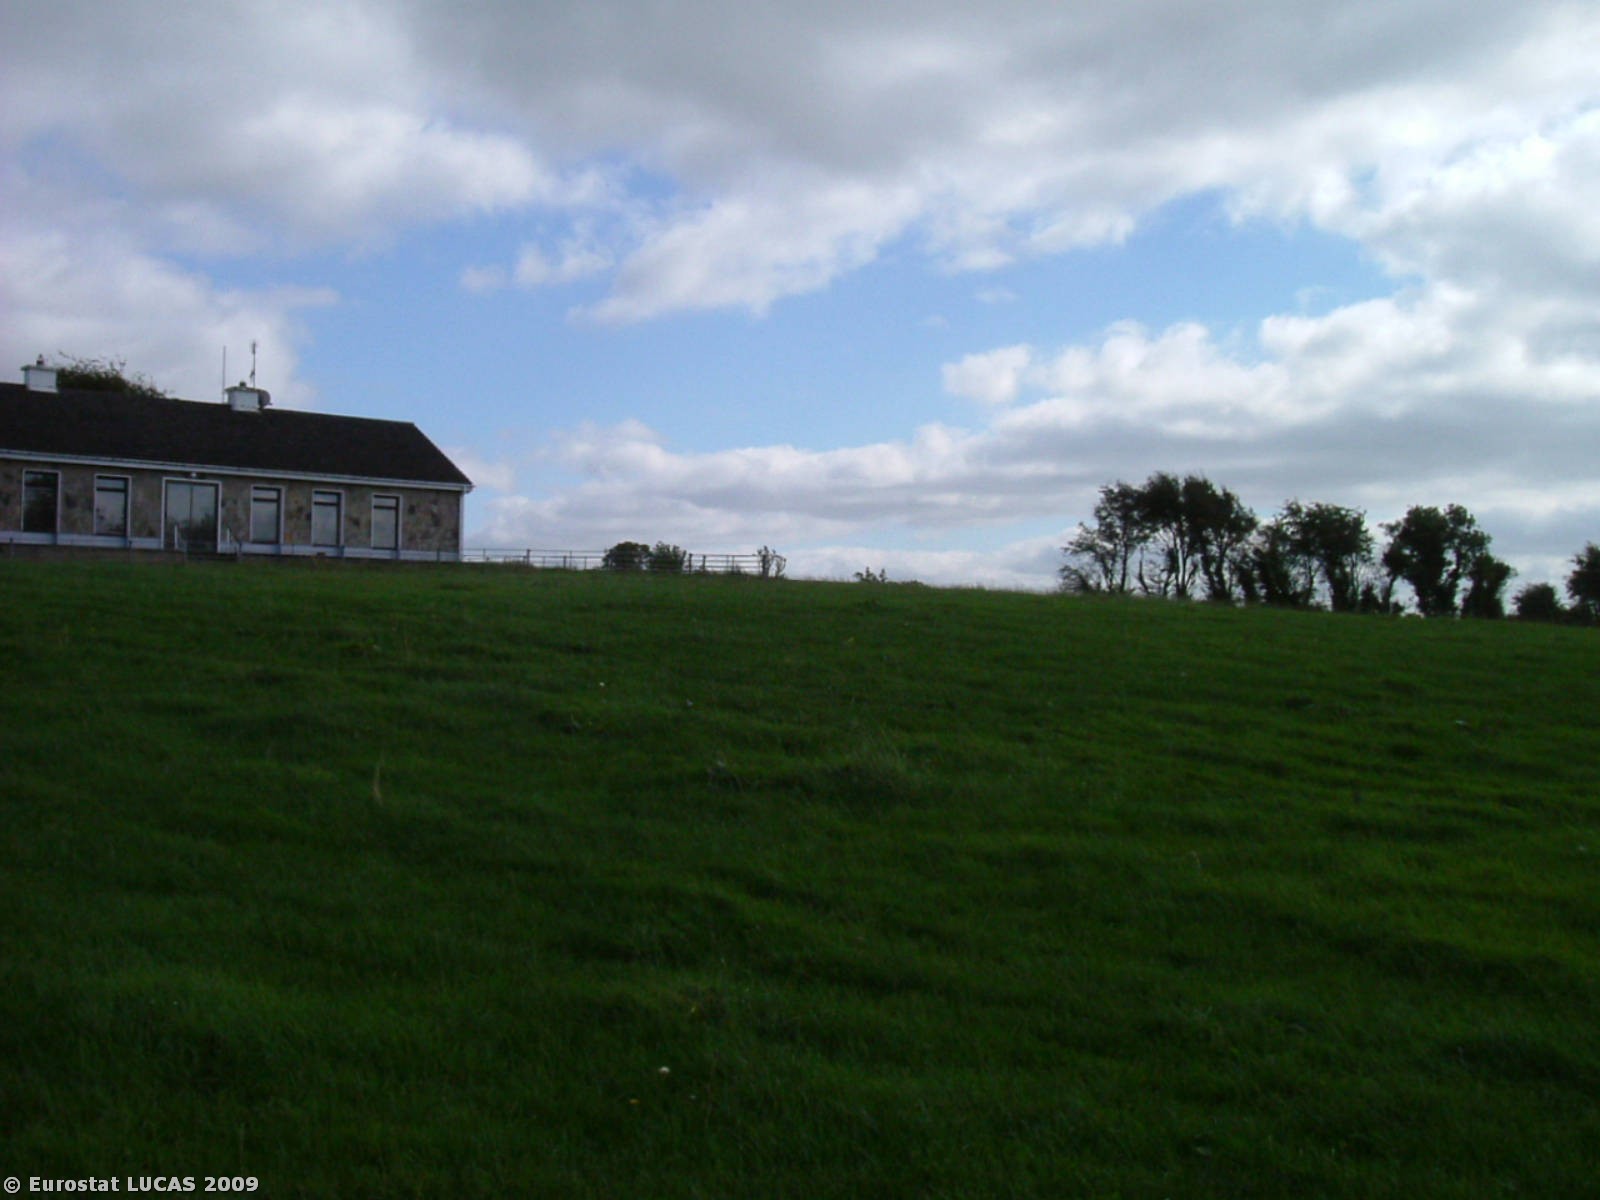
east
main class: Grassland
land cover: Grassland without tree/shrub cover
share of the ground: > 75 %
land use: Agriculture (excluding fallow land and kitchen gardens)
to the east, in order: Grassland without tree/shrub cover; Artificial constructions in urban areas; Spontaneously vegetated surfaces; Managed hedges; Grassland without tree/shrub cover
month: September
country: IE
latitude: 52.8038
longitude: -7.8060
